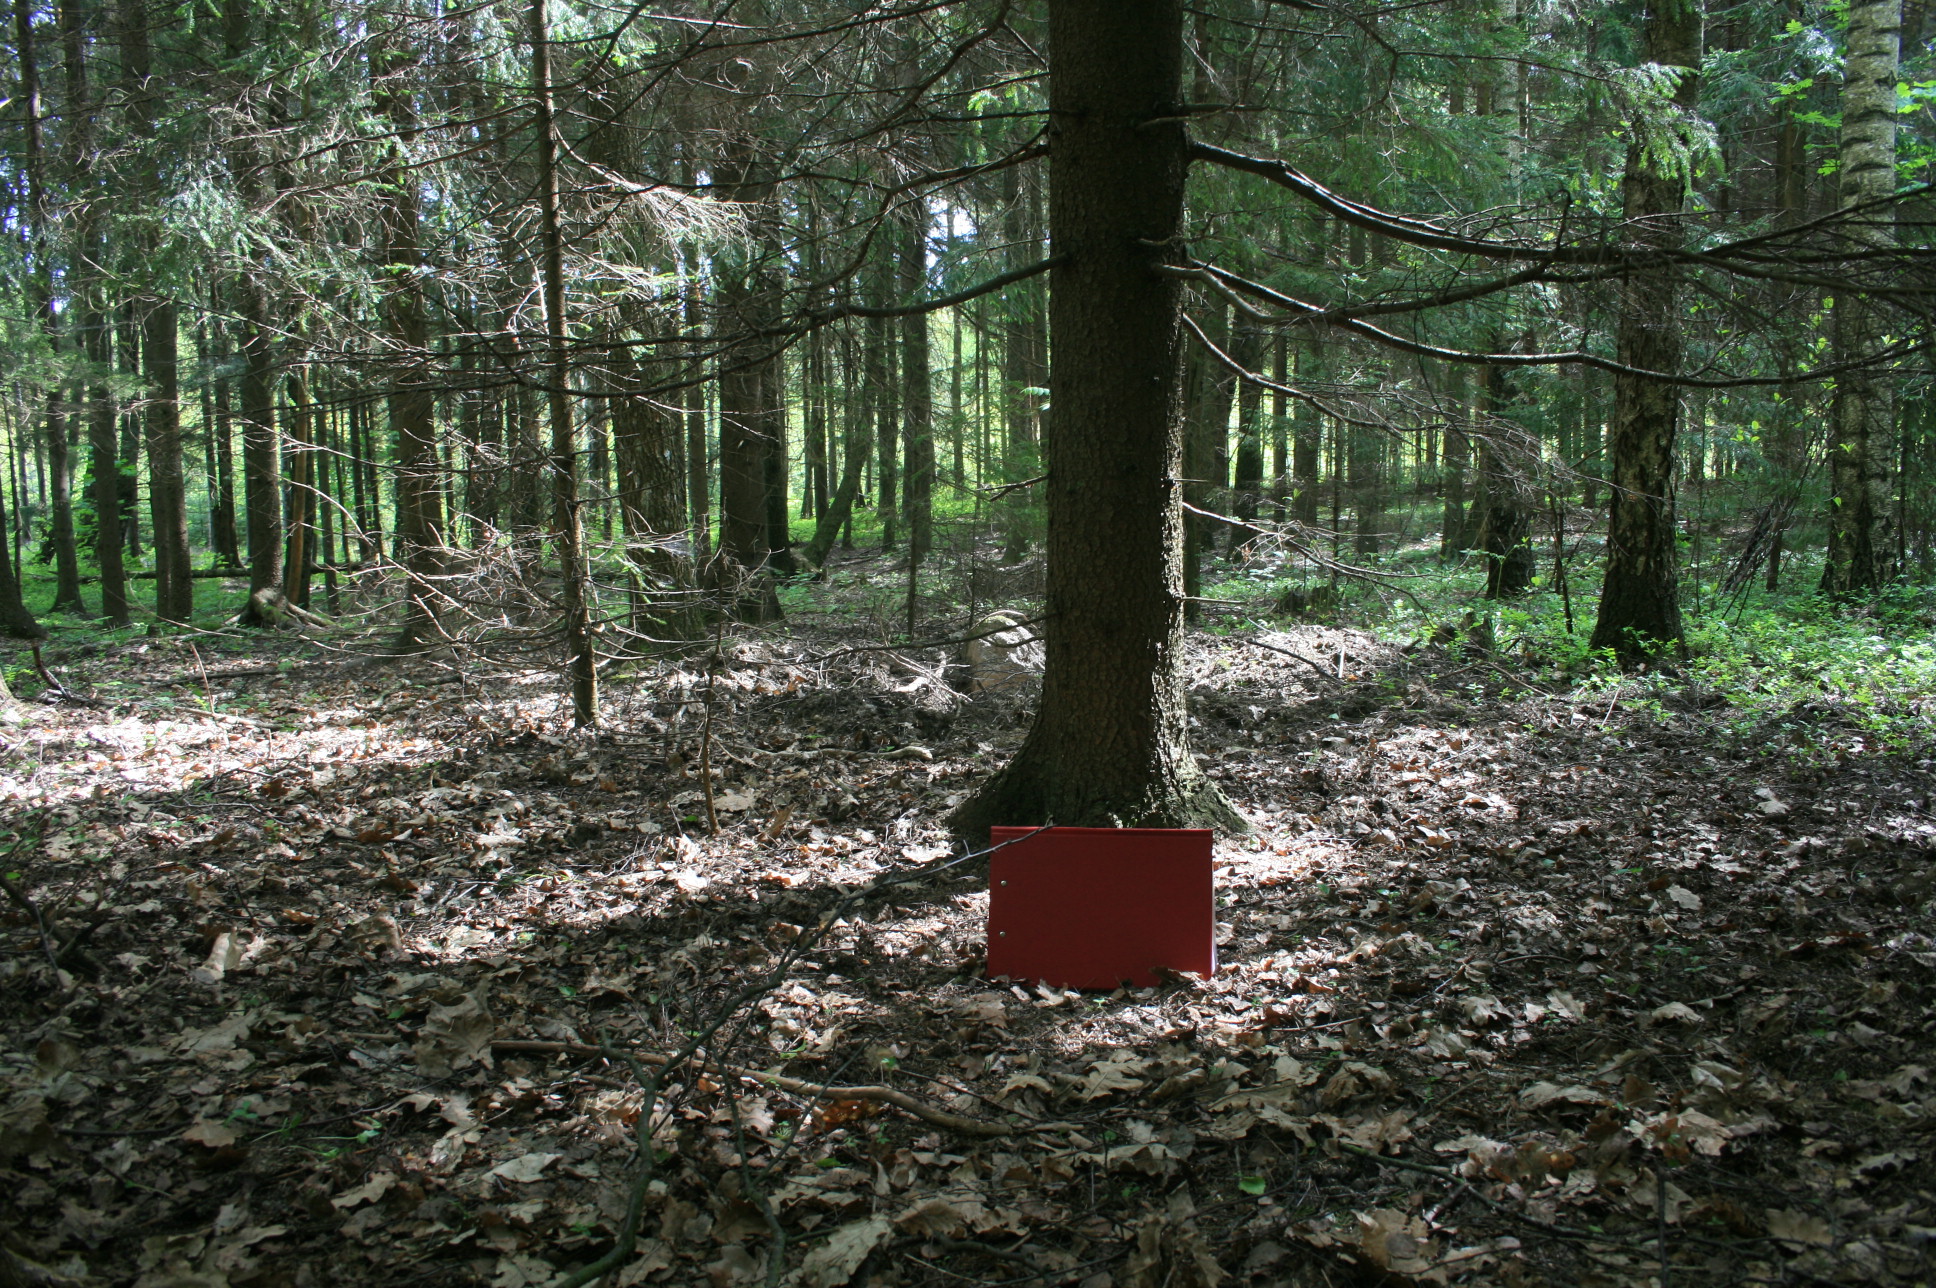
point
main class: Woodland
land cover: Spruce dominated mixed woodland
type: hemiboreal forest and nemoral coniferous forest and mixed broadleaved-coniferous forest
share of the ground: > 75 %
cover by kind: coniferous forest trees 70 %, broadleaved forest trees 30 %
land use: Forestry
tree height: > 5 m
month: May
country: LT
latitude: 55.7629
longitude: 21.8595
